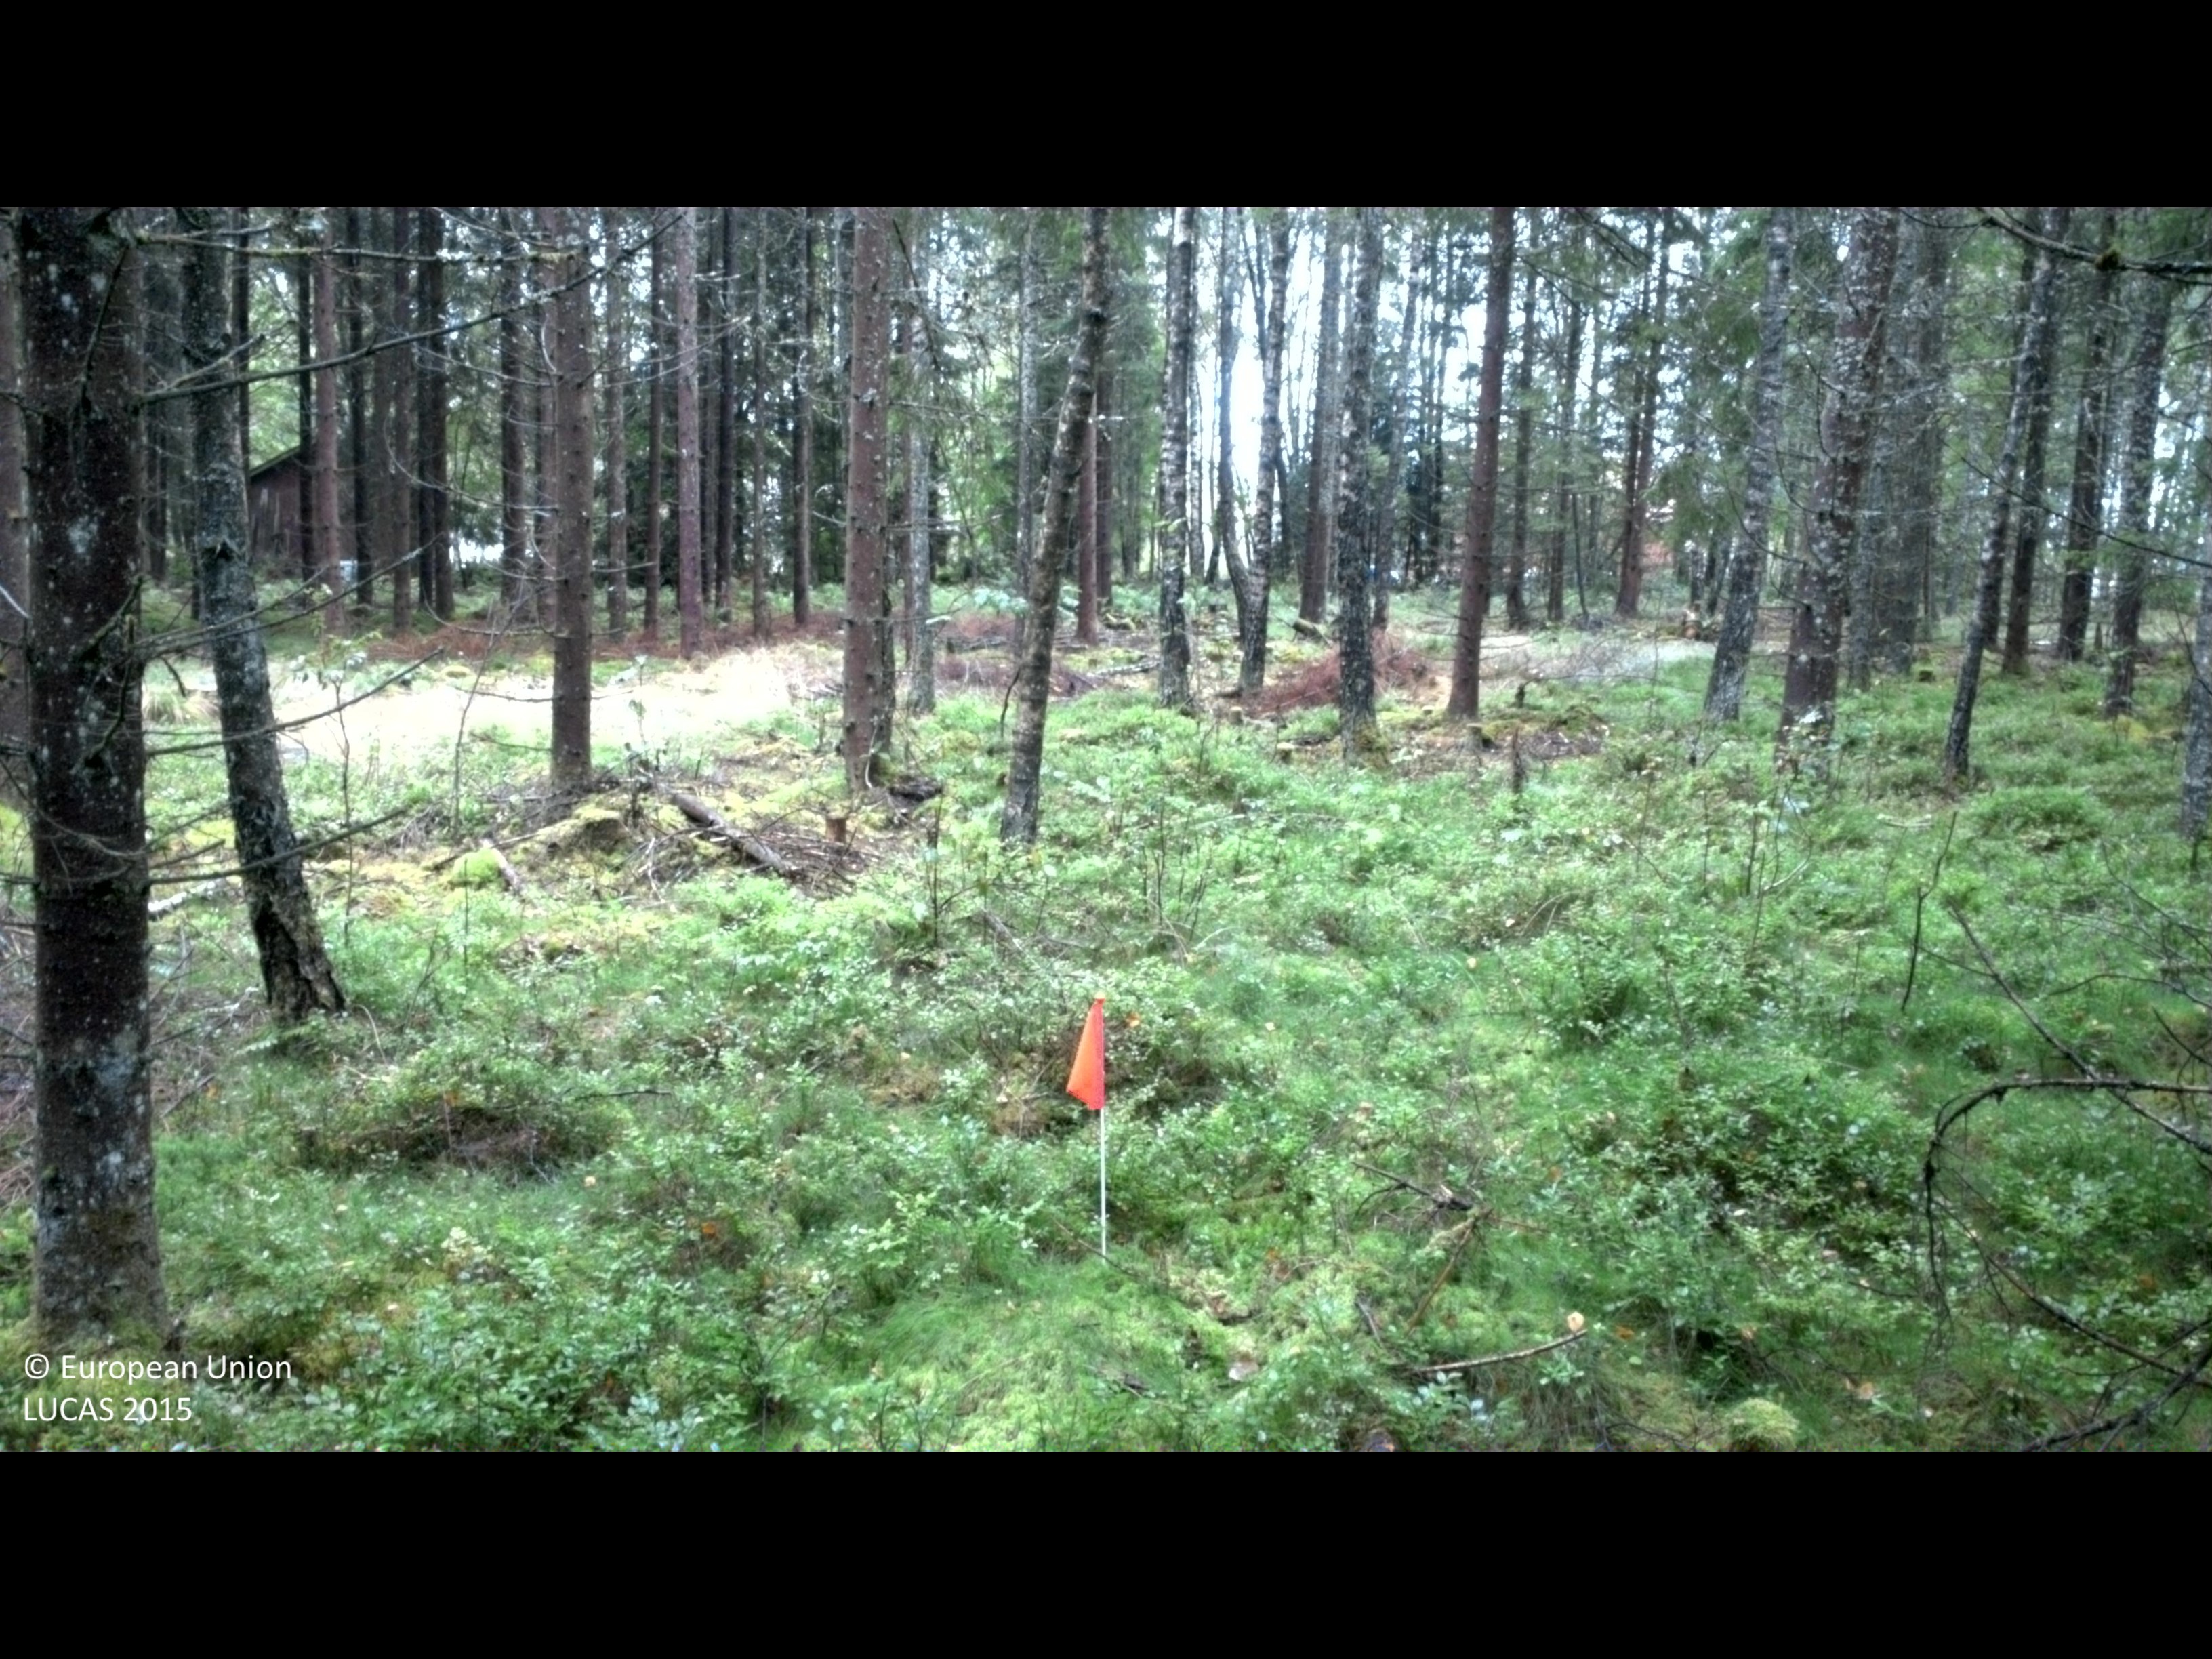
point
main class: Woodland
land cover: Spruce dominated coniferous woodland
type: boreal forest
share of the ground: 50 - 75 %
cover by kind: coniferous forest trees 55 %, shrubs 35 %, broadleaved forest trees 5 %, herbaceous plants 5 %
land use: Forestry
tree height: > 5 m
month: September
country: SE
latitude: 57.3905
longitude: 13.8389
